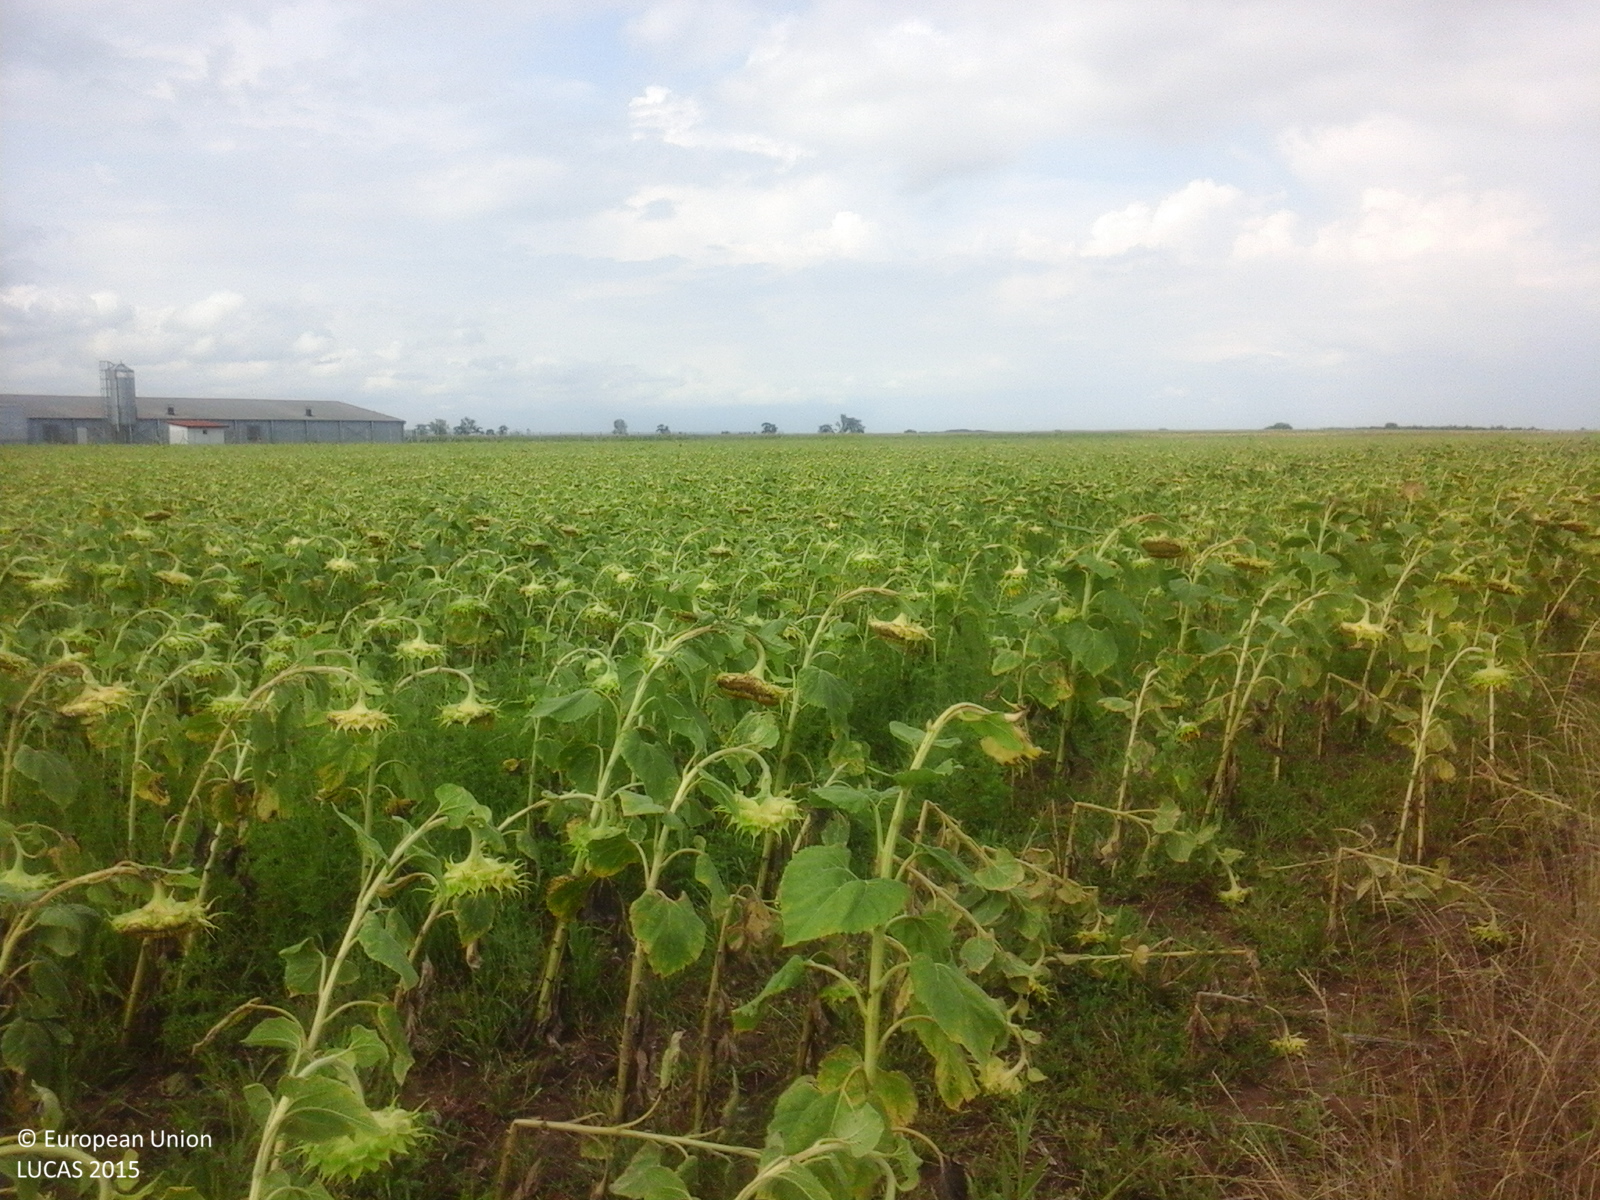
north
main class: Cropland
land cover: Sunflower
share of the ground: > 75 %
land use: Agriculture (excluding fallow land and kitchen gardens)
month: August
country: RO
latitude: 45.5528
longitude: 21.4453
